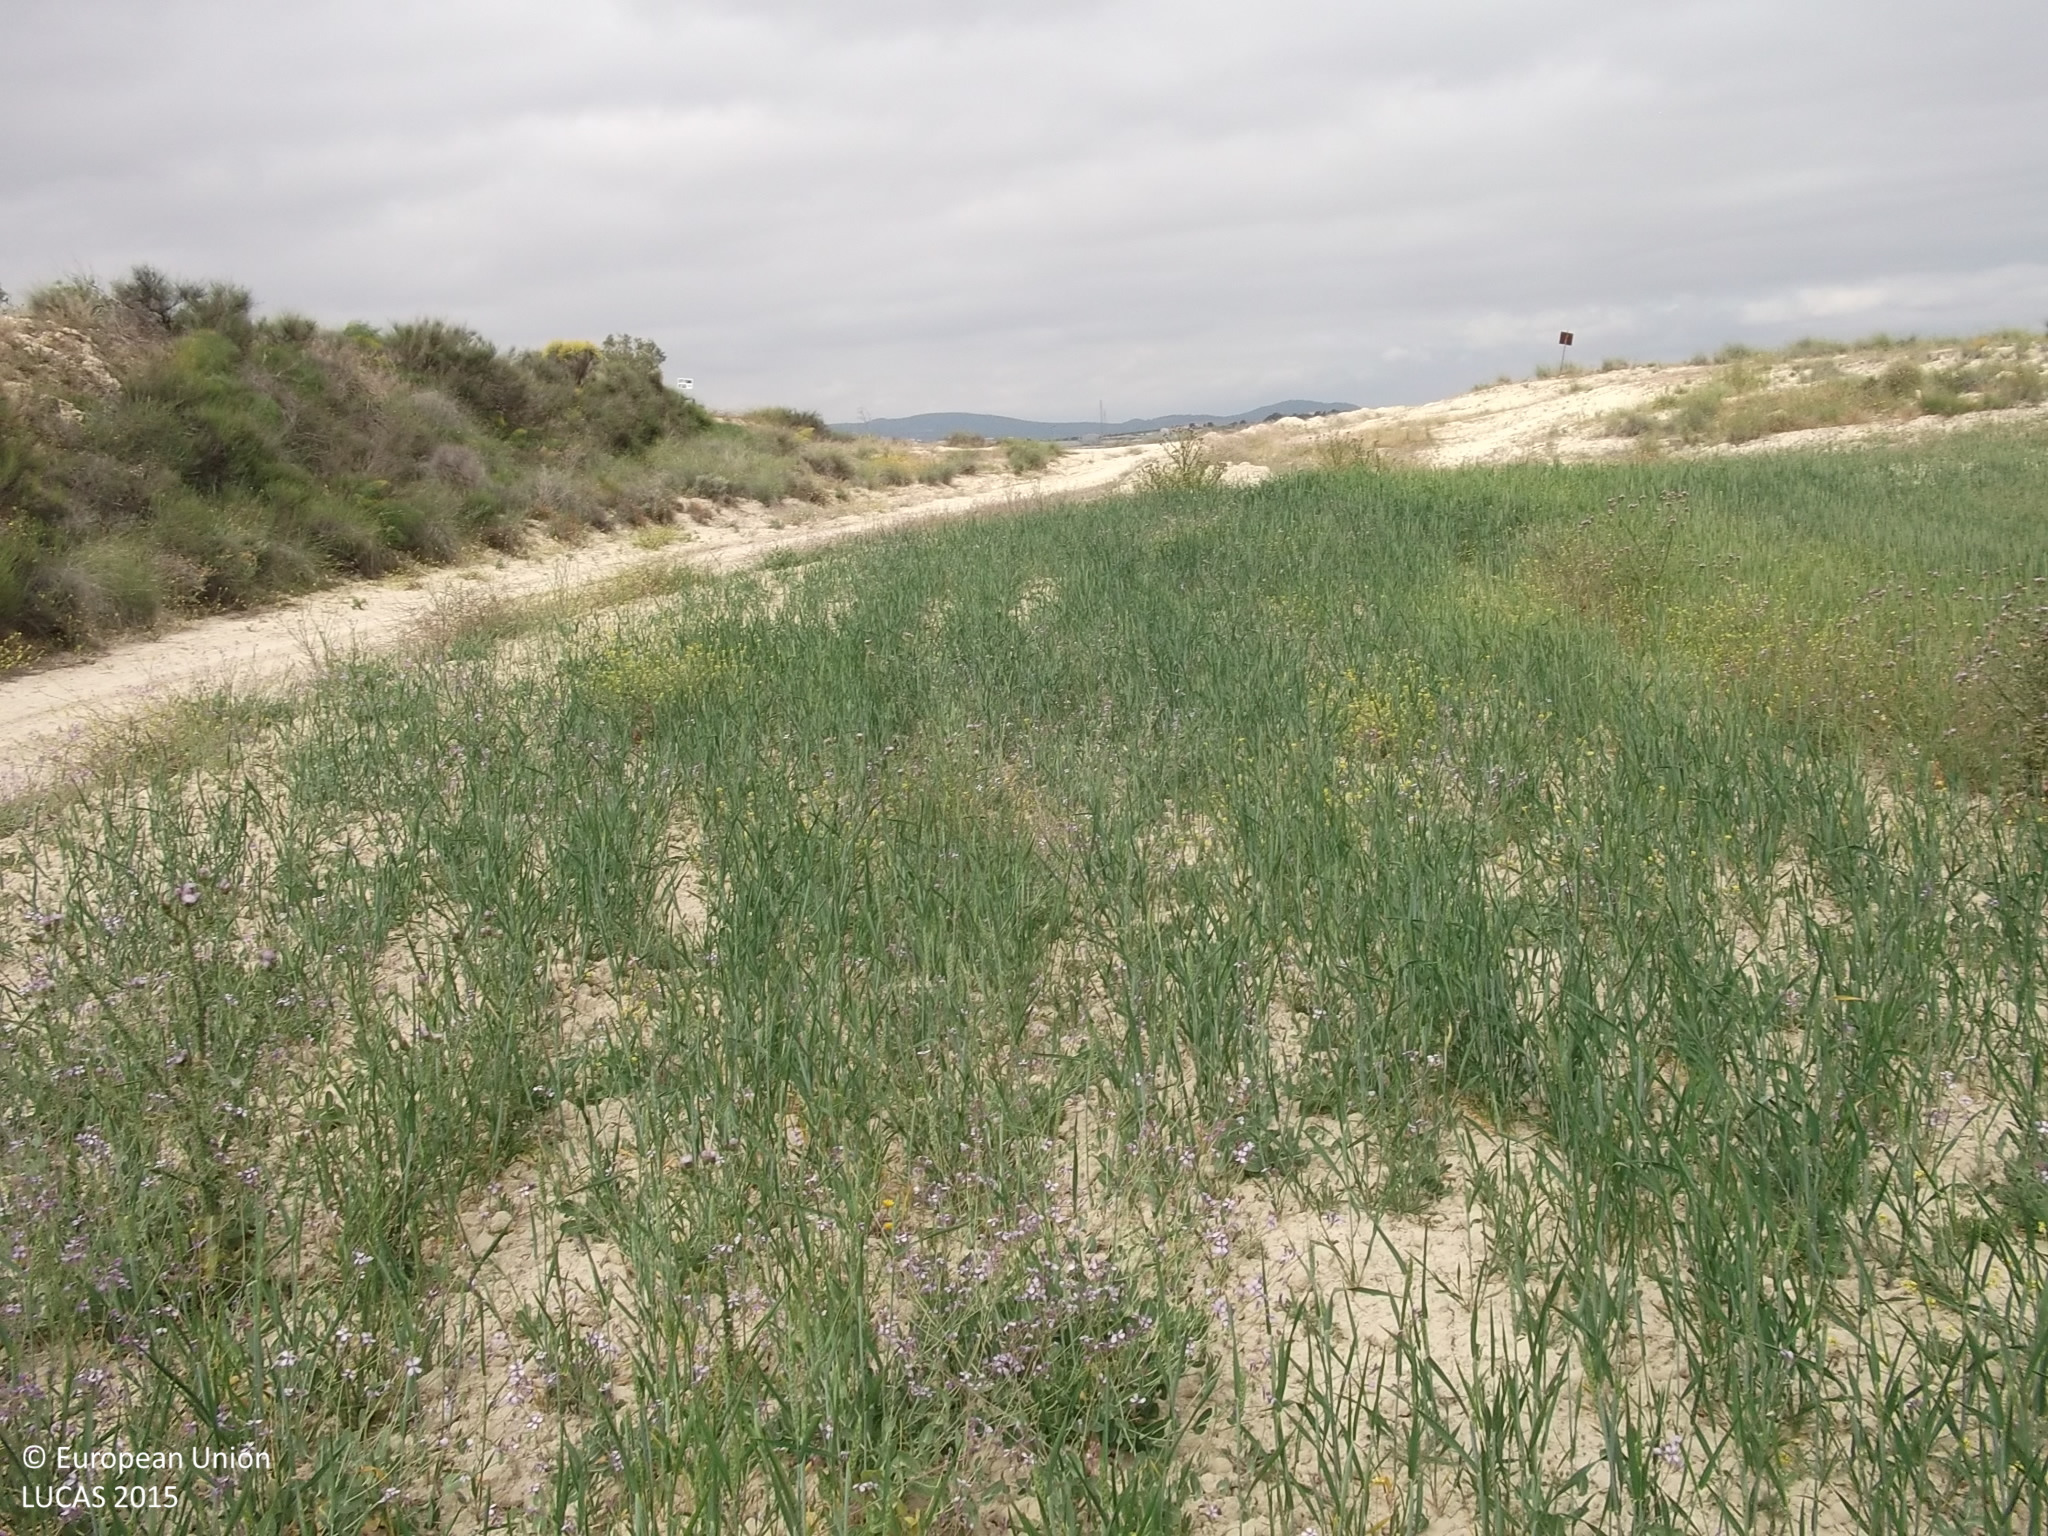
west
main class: Cropland
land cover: Common wheat
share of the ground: > 75 %
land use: Agriculture (excluding fallow land and kitchen gardens)
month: April
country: ES
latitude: 37.9973
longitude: -1.3612
